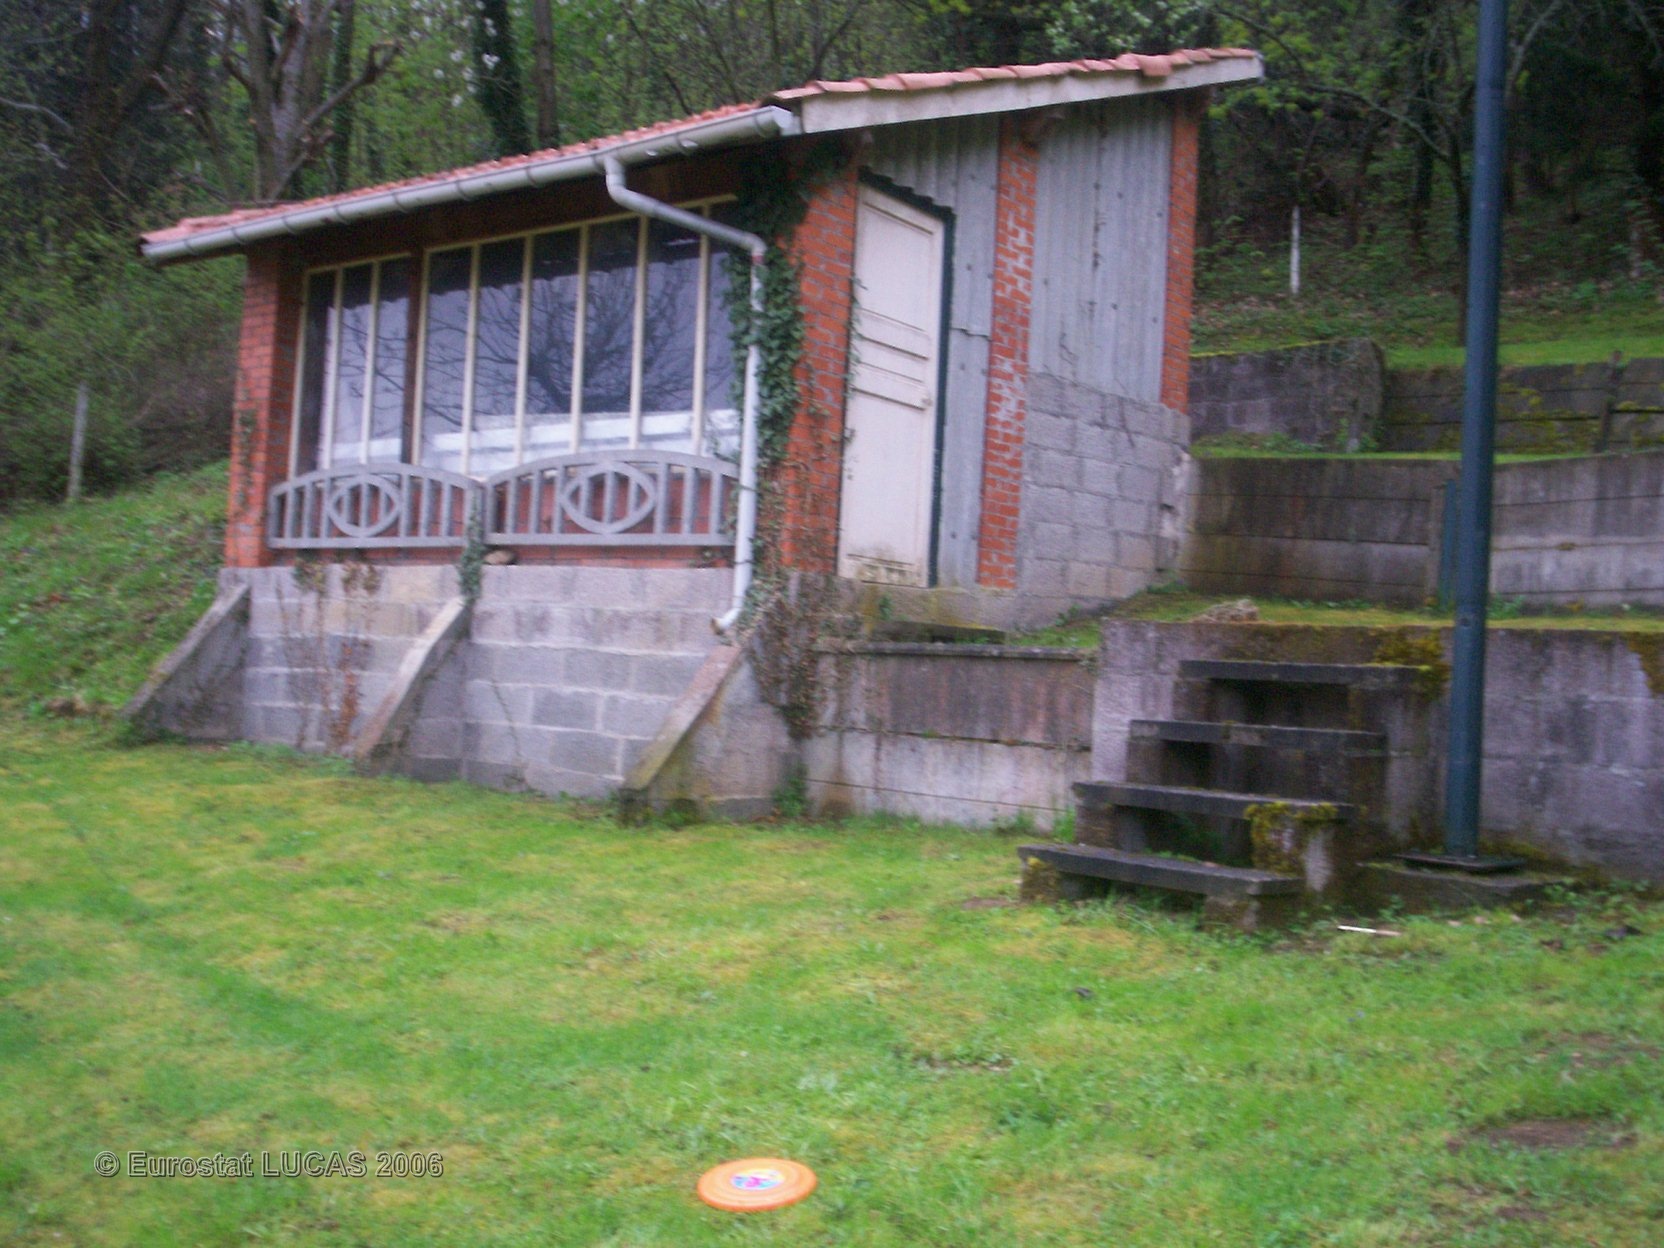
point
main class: Grassland
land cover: Grassland with sparse tree/shrub cover
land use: Residential
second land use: Kitchen garden
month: April
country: FR
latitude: 45.7631
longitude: 3.0436
